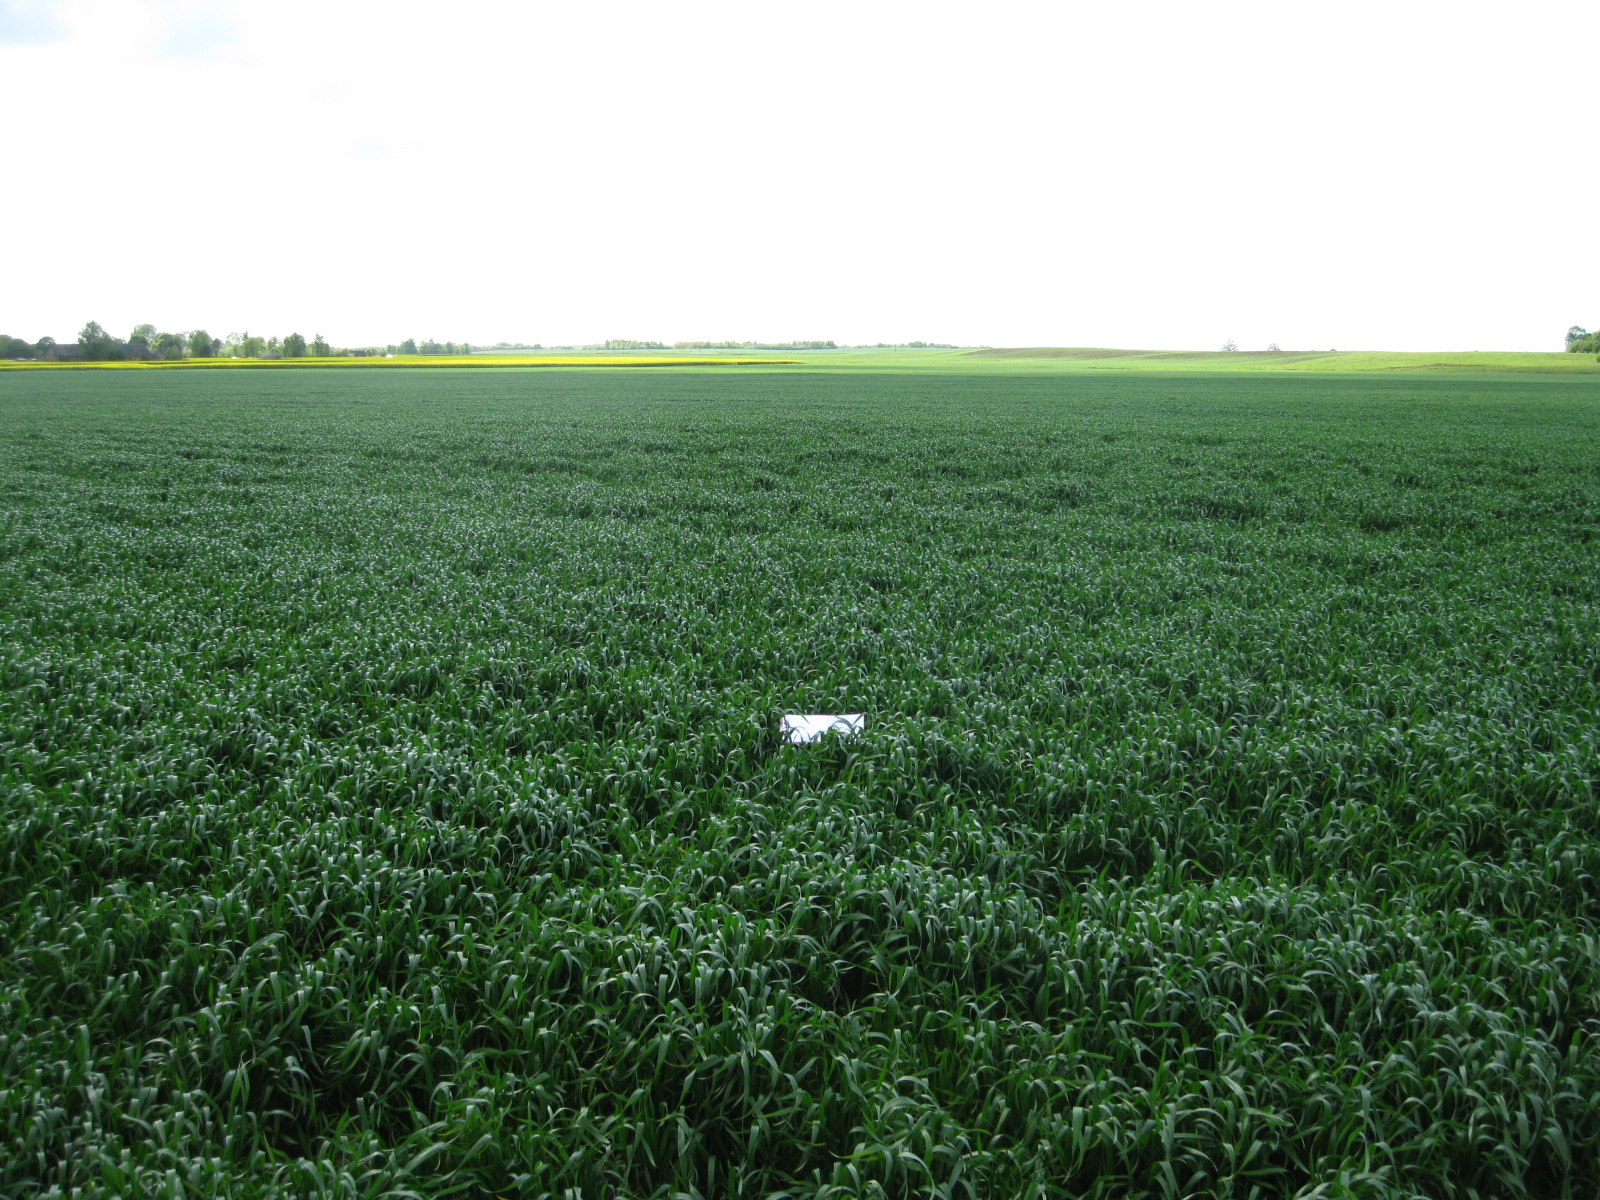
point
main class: Cropland
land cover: Common wheat
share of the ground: > 75 %
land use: Agriculture (excluding fallow land and kitchen gardens)
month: May
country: LT
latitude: 56.0609
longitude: 23.9457
